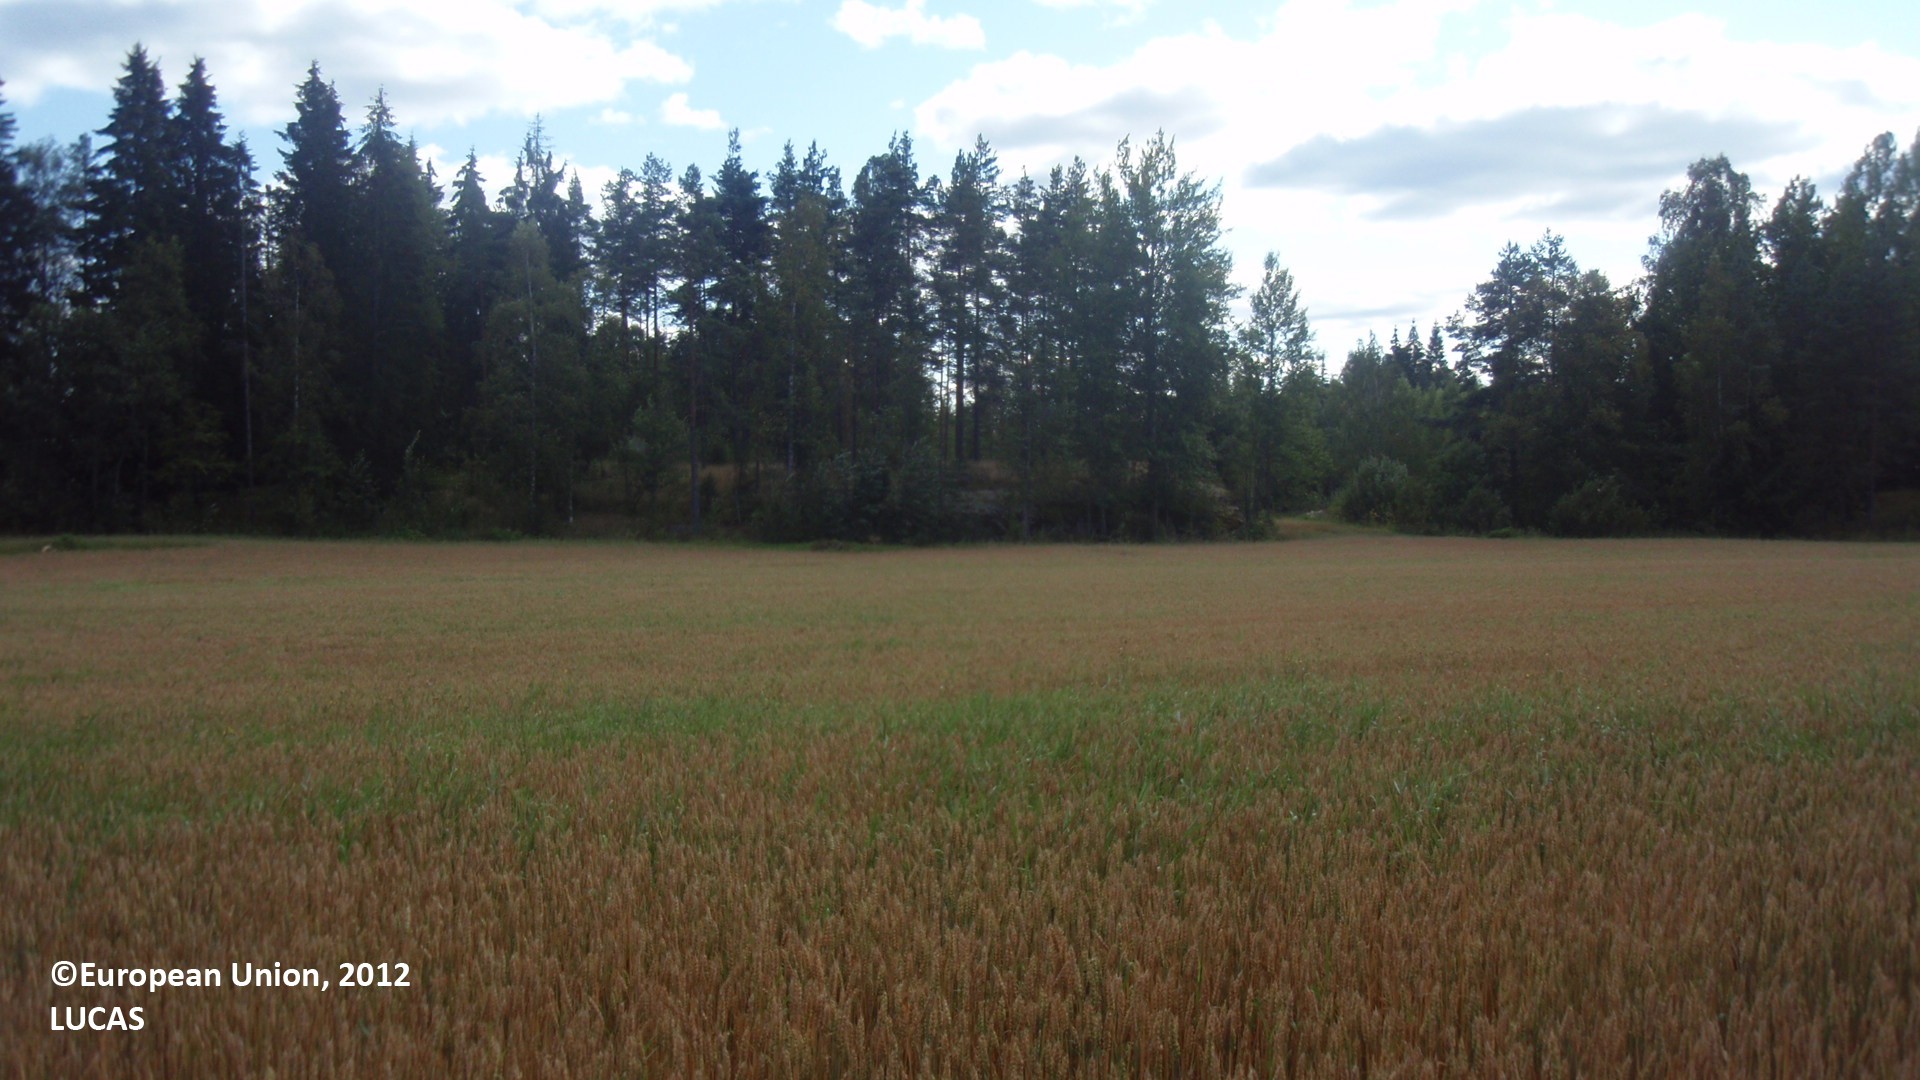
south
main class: Cropland
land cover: Common wheat
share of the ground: > 75 %
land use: Agriculture (excluding fallow land and kitchen gardens)
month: August
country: FI
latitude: 60.6854
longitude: 27.4877
